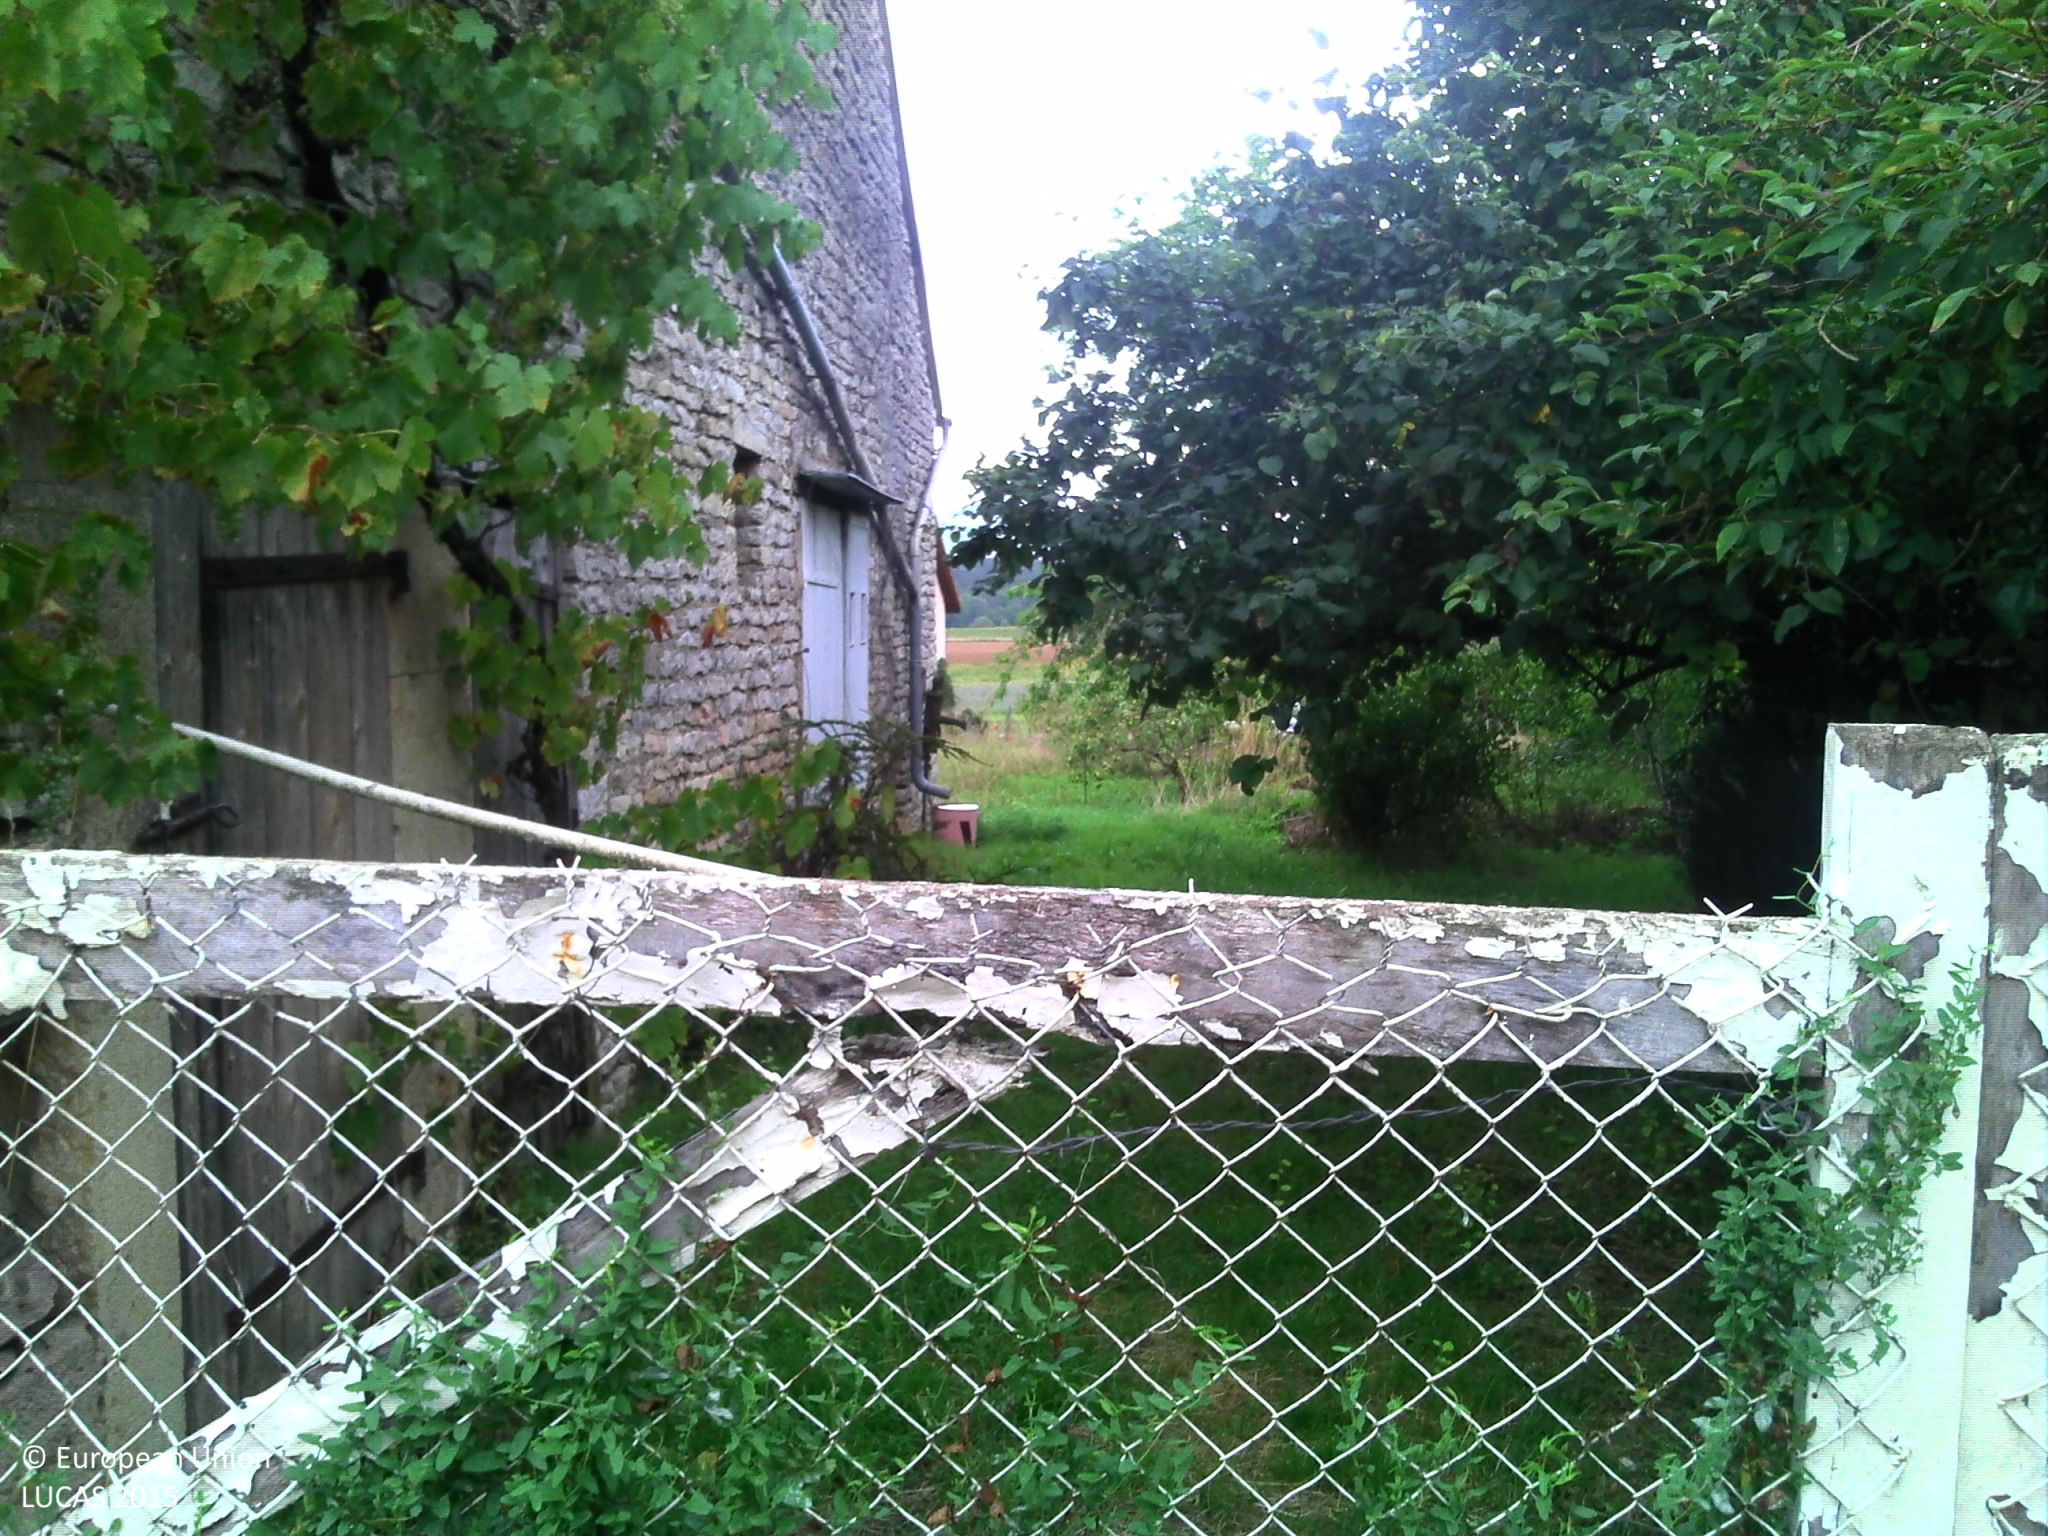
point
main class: Grassland
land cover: Grassland with sparse tree/shrub cover
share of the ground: > 75 %
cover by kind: herbaceous plants 95 %, broadleaved forest trees 5 %
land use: Residential
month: August
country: FR
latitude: 47.3254
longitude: 4.8001
